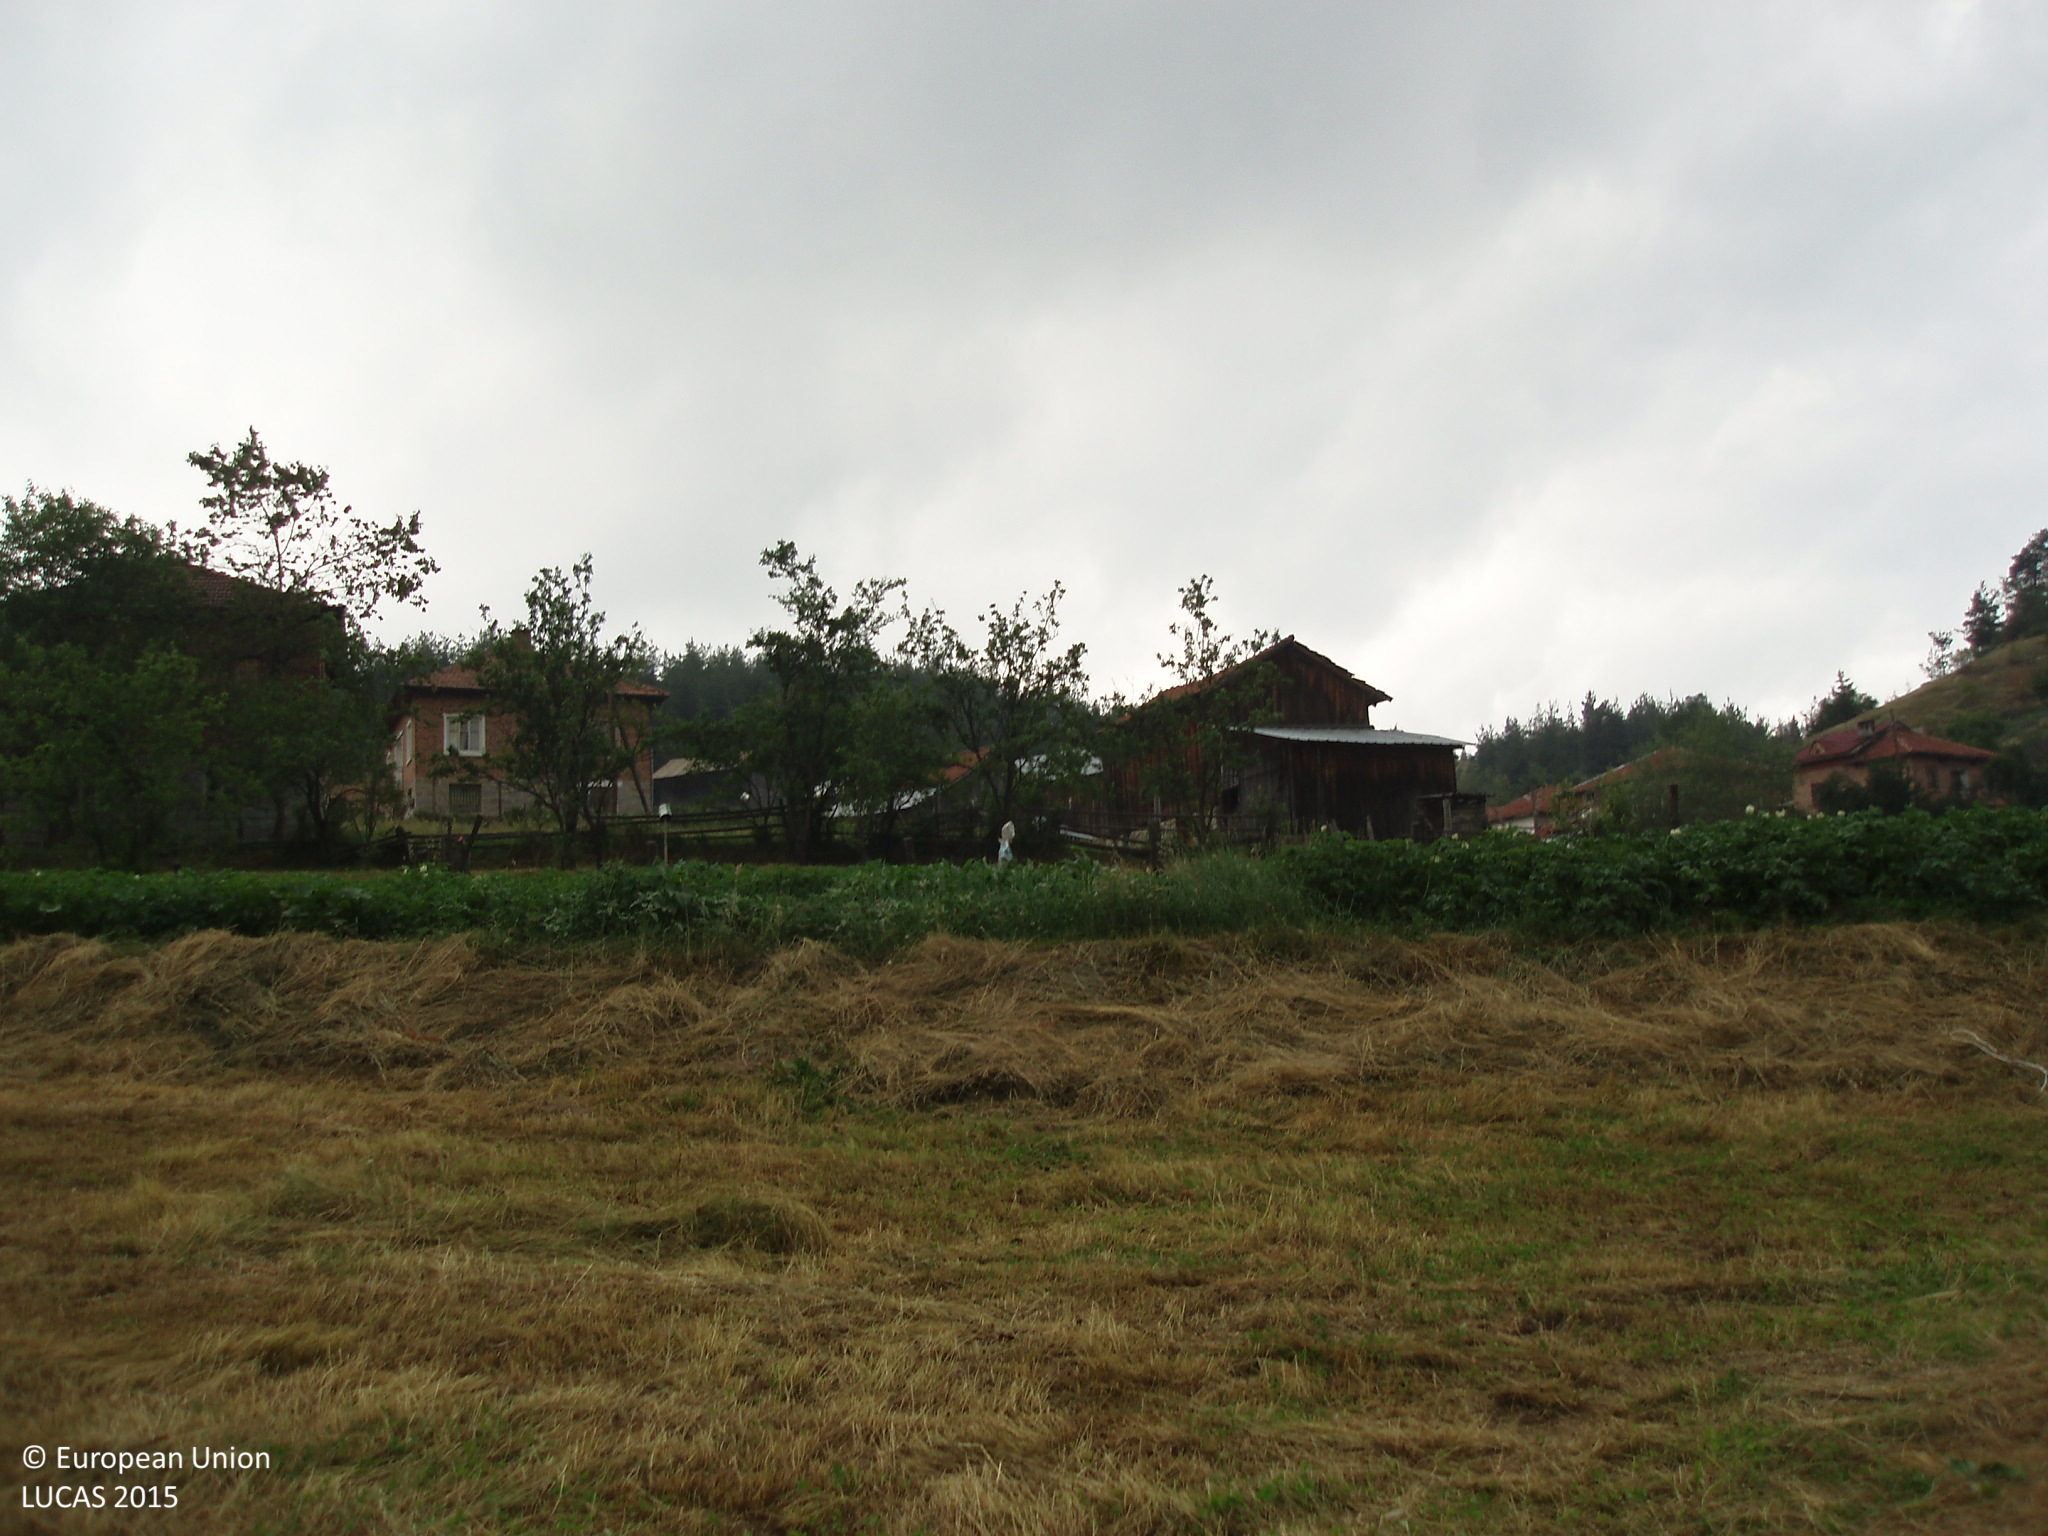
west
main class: Grassland
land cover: Grassland without tree/shrub cover
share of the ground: > 75 %
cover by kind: herbaceous plants 100 %
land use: Agriculture (excluding fallow land and kitchen gardens)
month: July
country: BG
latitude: 42.0057
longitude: 23.7370
